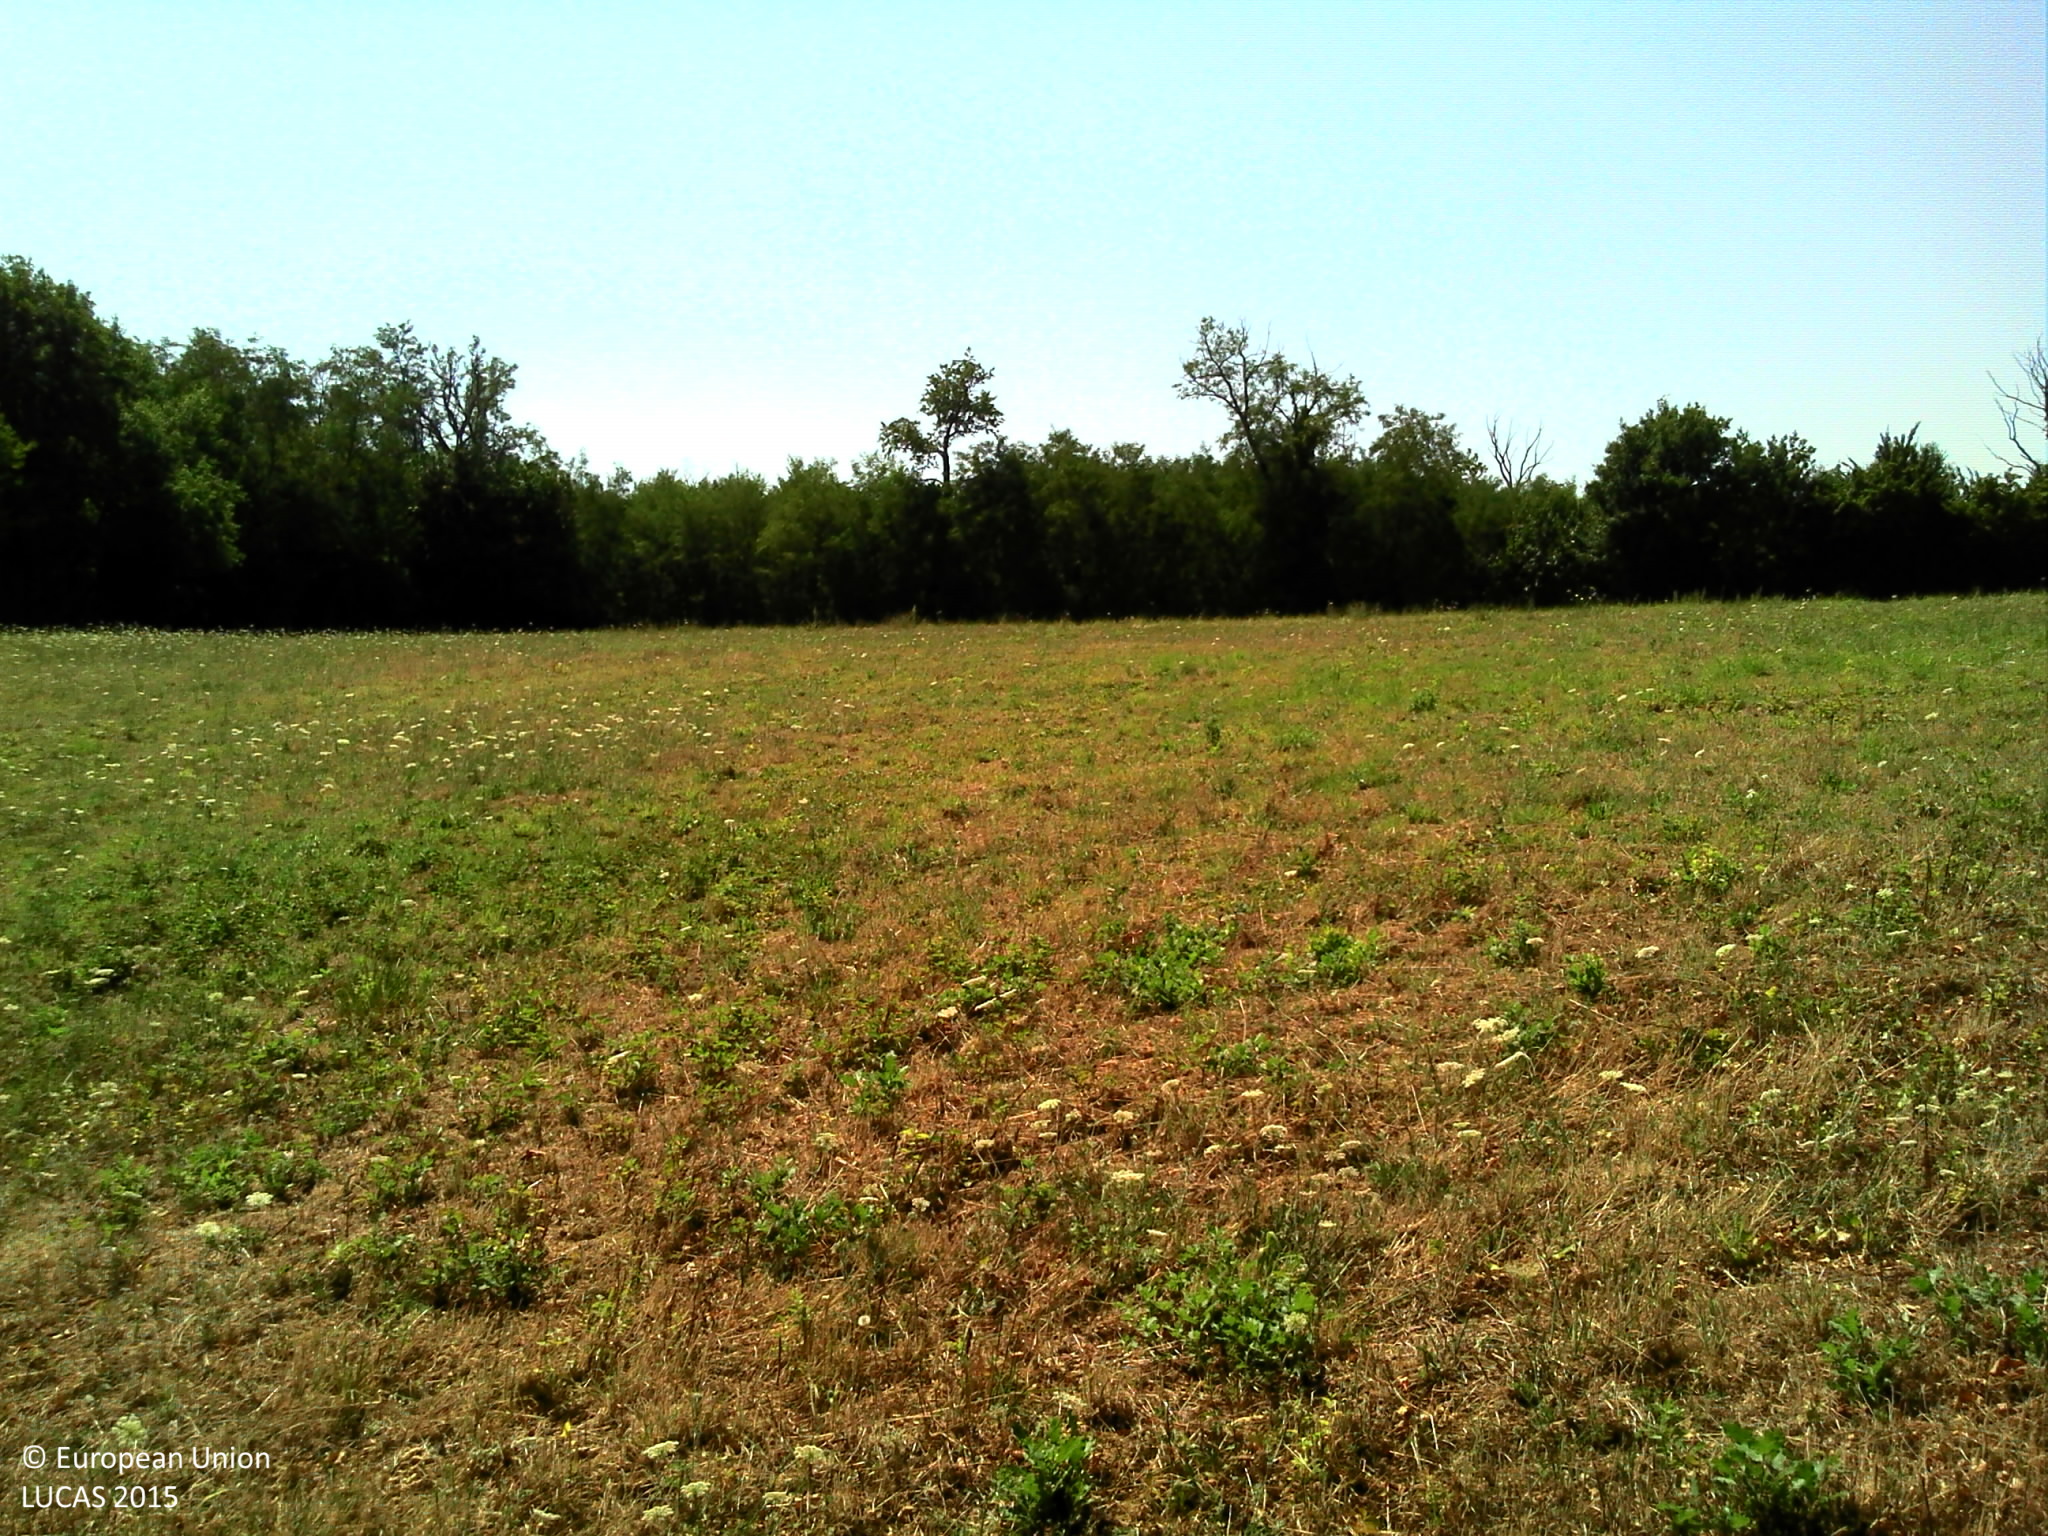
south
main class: Woodland
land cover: Broadleaved woodland
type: mesophytic deciduous forest
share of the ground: > 75 %
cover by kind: broadleaved forest trees 85 %, shrubs 10 %, herbaceous plants 5 %
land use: Forestry
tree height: > 5 m
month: August
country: FR
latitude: 46.2889
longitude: 0.2855
